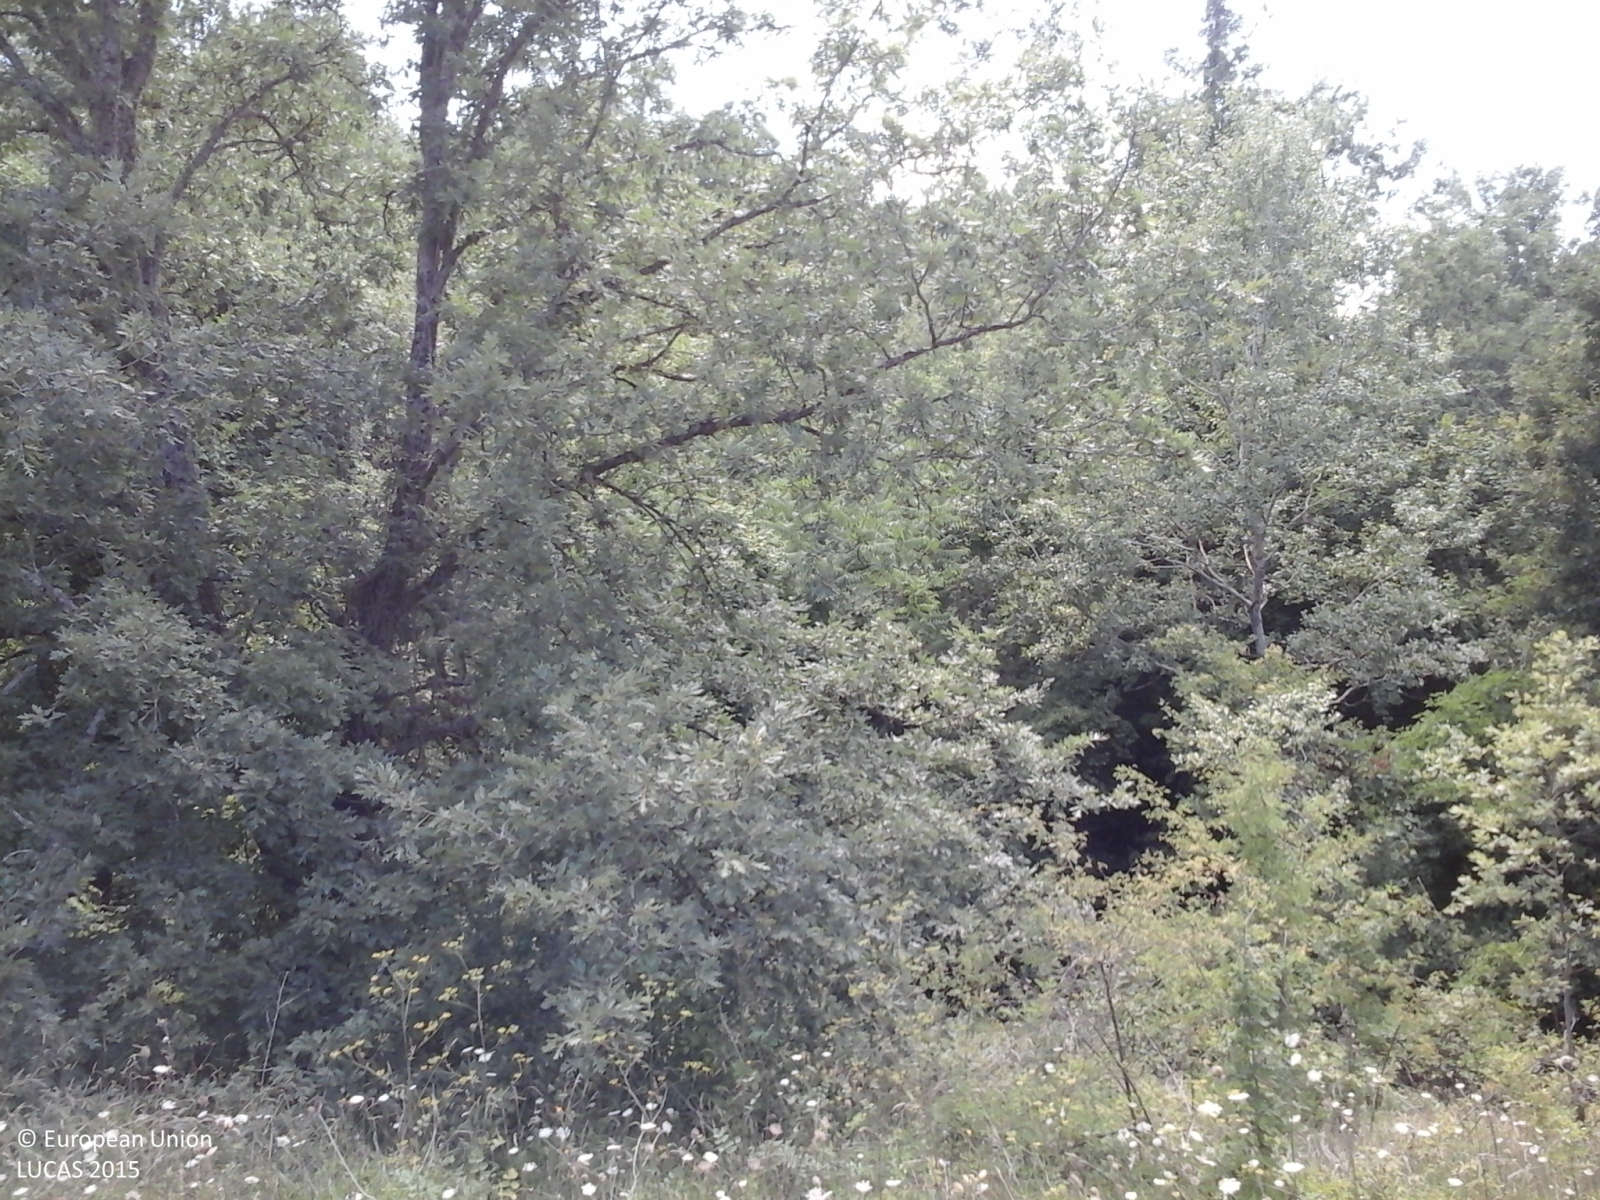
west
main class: Woodland
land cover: Broadleaved woodland
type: thermophilous deciduous forest
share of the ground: > 75 %
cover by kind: broadleaved forest trees 75 %, shrubs 20 %, herbaceous plants 5 %
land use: Semi-natural and natural areas not in use
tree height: > 5 m
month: August
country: IT
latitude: 41.5831
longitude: 14.3626
